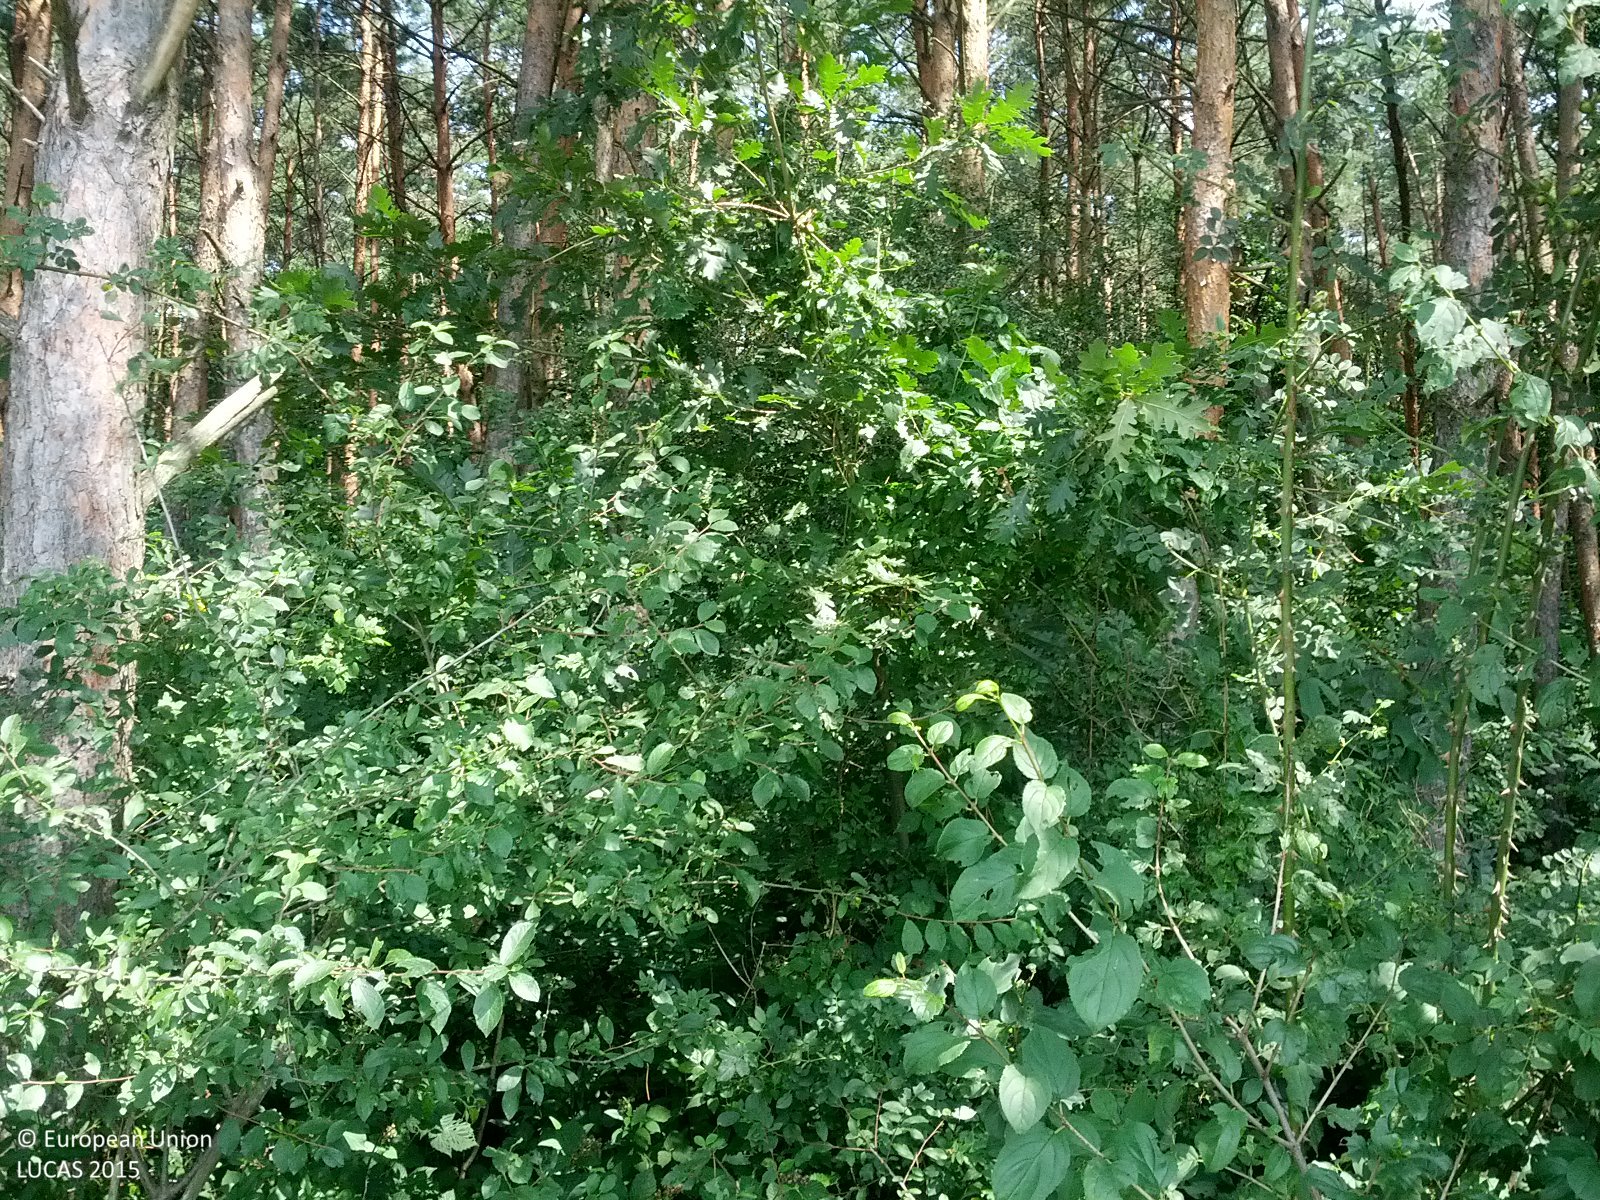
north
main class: Woodland
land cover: Pine dominated coniferous woodland
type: hemiboreal forest and nemoral coniferous forest and mixed broadleaved-coniferous forest
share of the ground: > 75 %
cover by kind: coniferous forest trees 80 %, shrubs 10 %, herbaceous plants 10 %
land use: Forestry
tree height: > 5 m
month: July
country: AT
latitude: 47.2457
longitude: 16.3575
